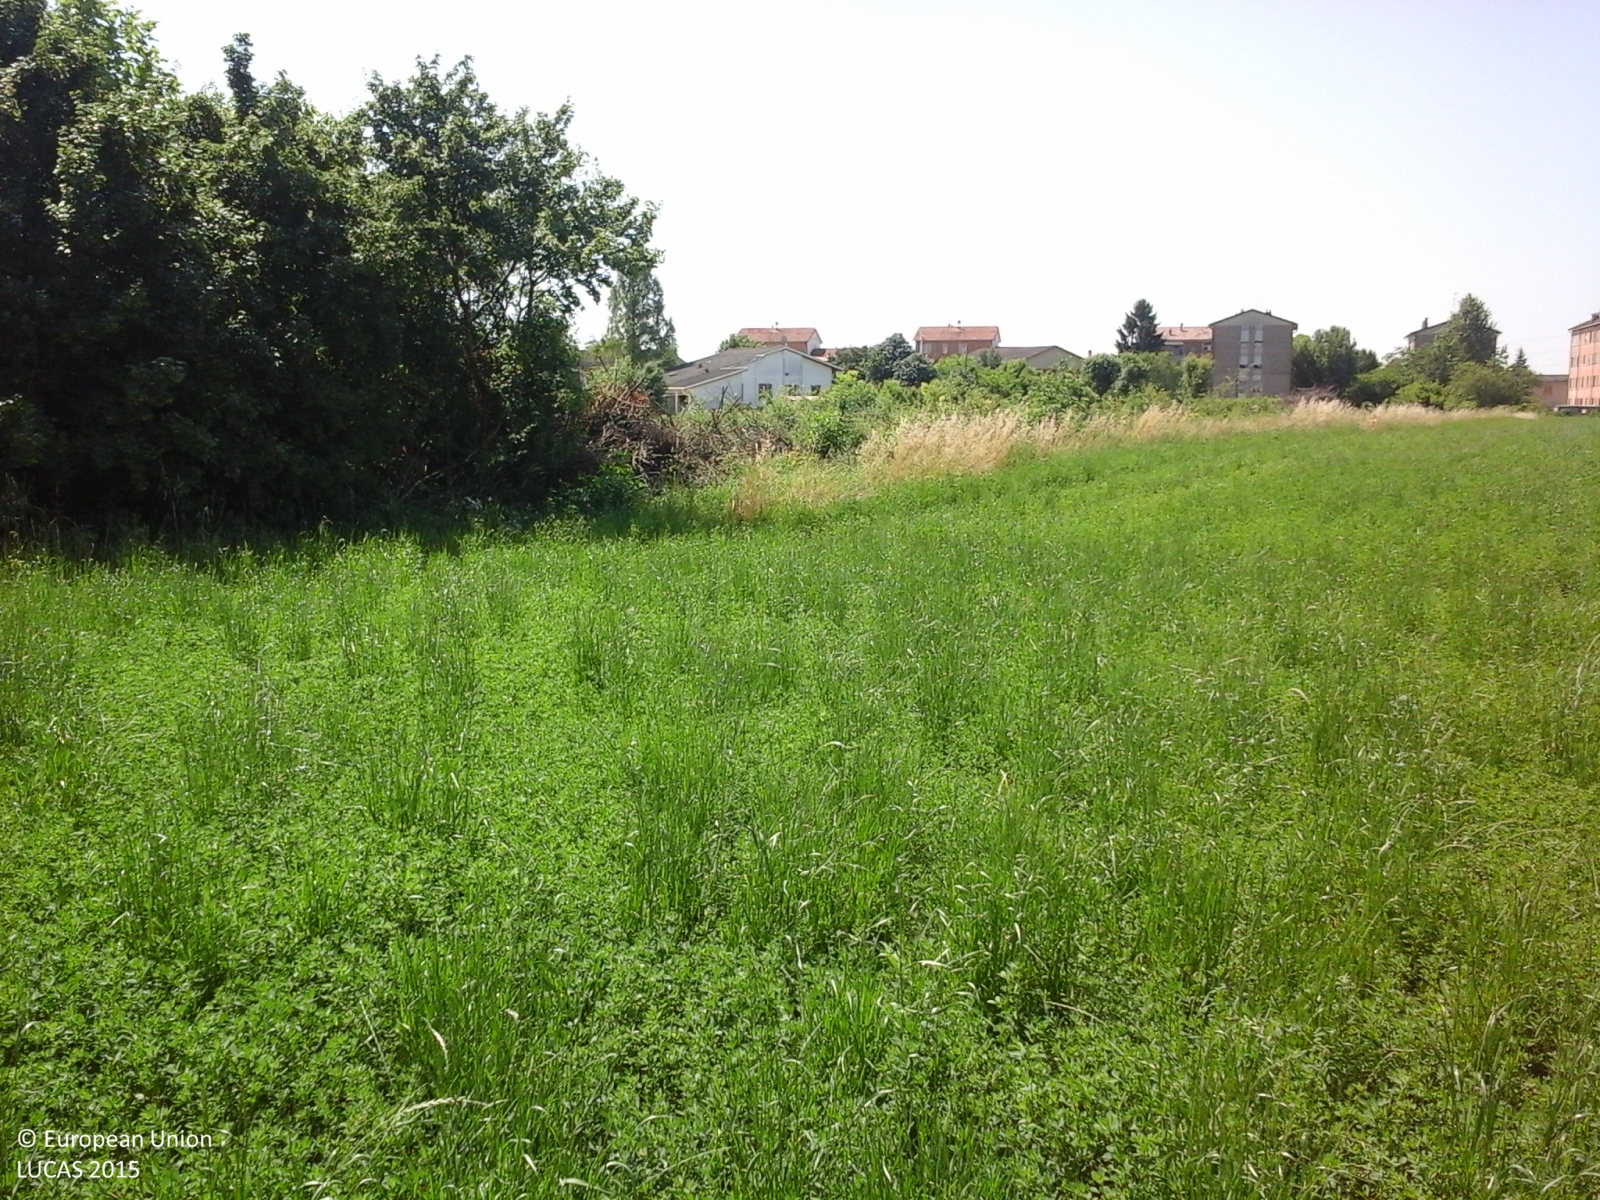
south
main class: Cropland
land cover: Lucerne
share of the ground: > 75 %
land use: Agriculture (excluding fallow land and kitchen gardens)
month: May
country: IT
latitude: 45.1403
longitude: 10.8758
